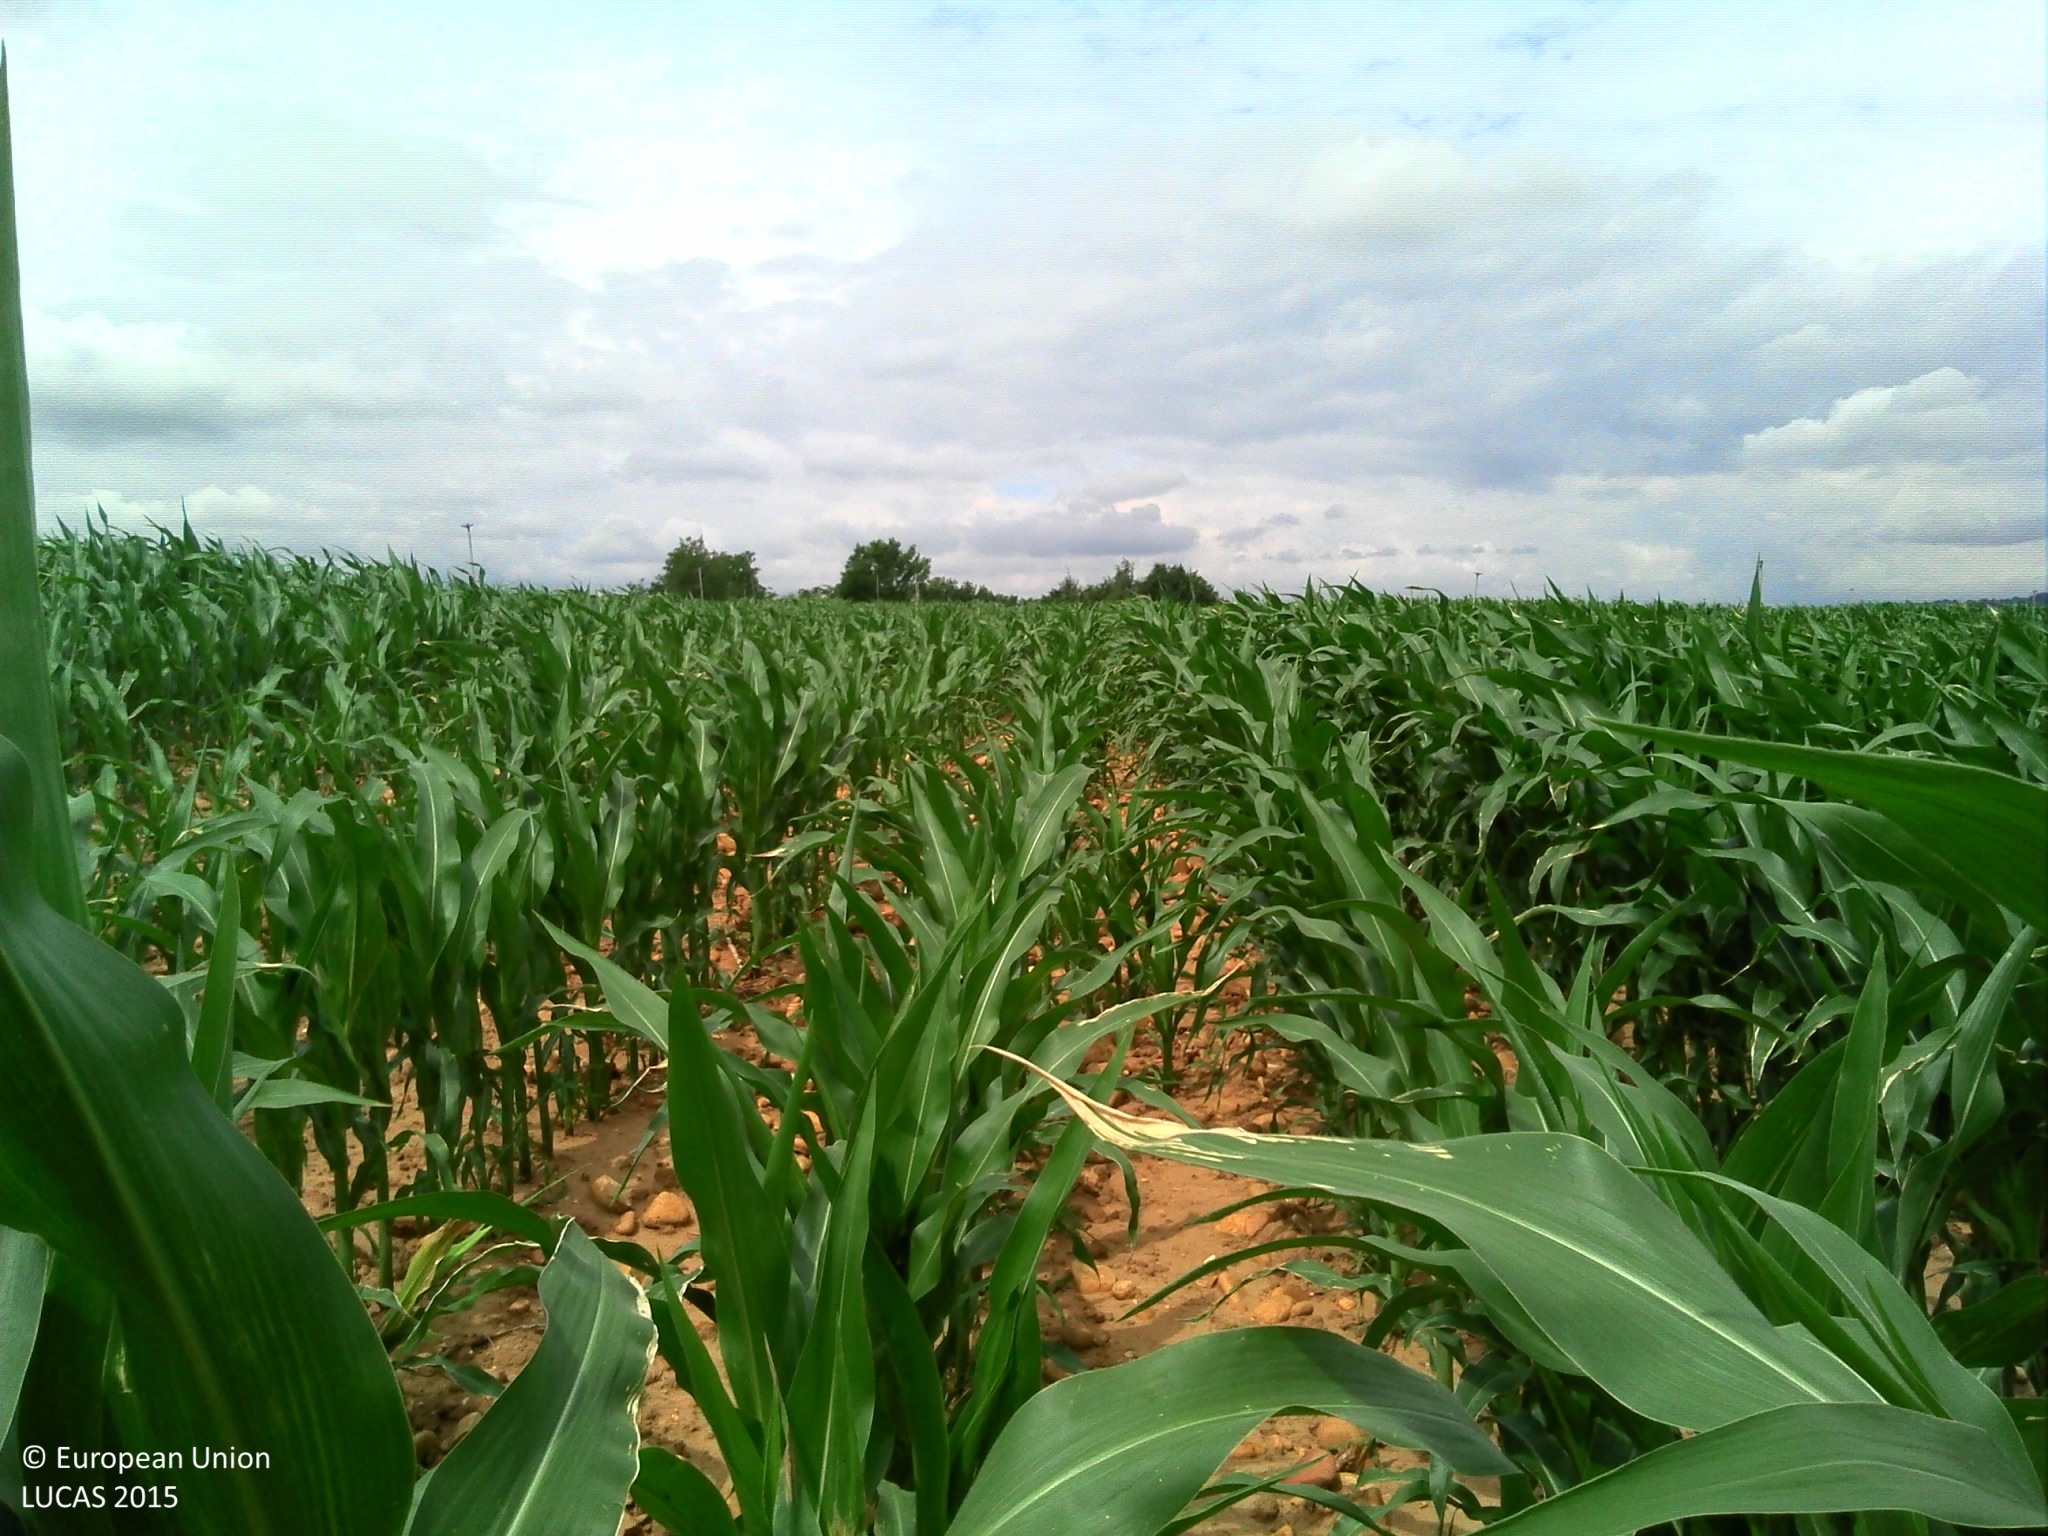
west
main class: Cropland
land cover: Maize
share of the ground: > 75 %
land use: Agriculture (excluding fallow land and kitchen gardens)
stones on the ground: 25 - 50 %
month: June
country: FR
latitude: 45.1647
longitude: 4.9035
